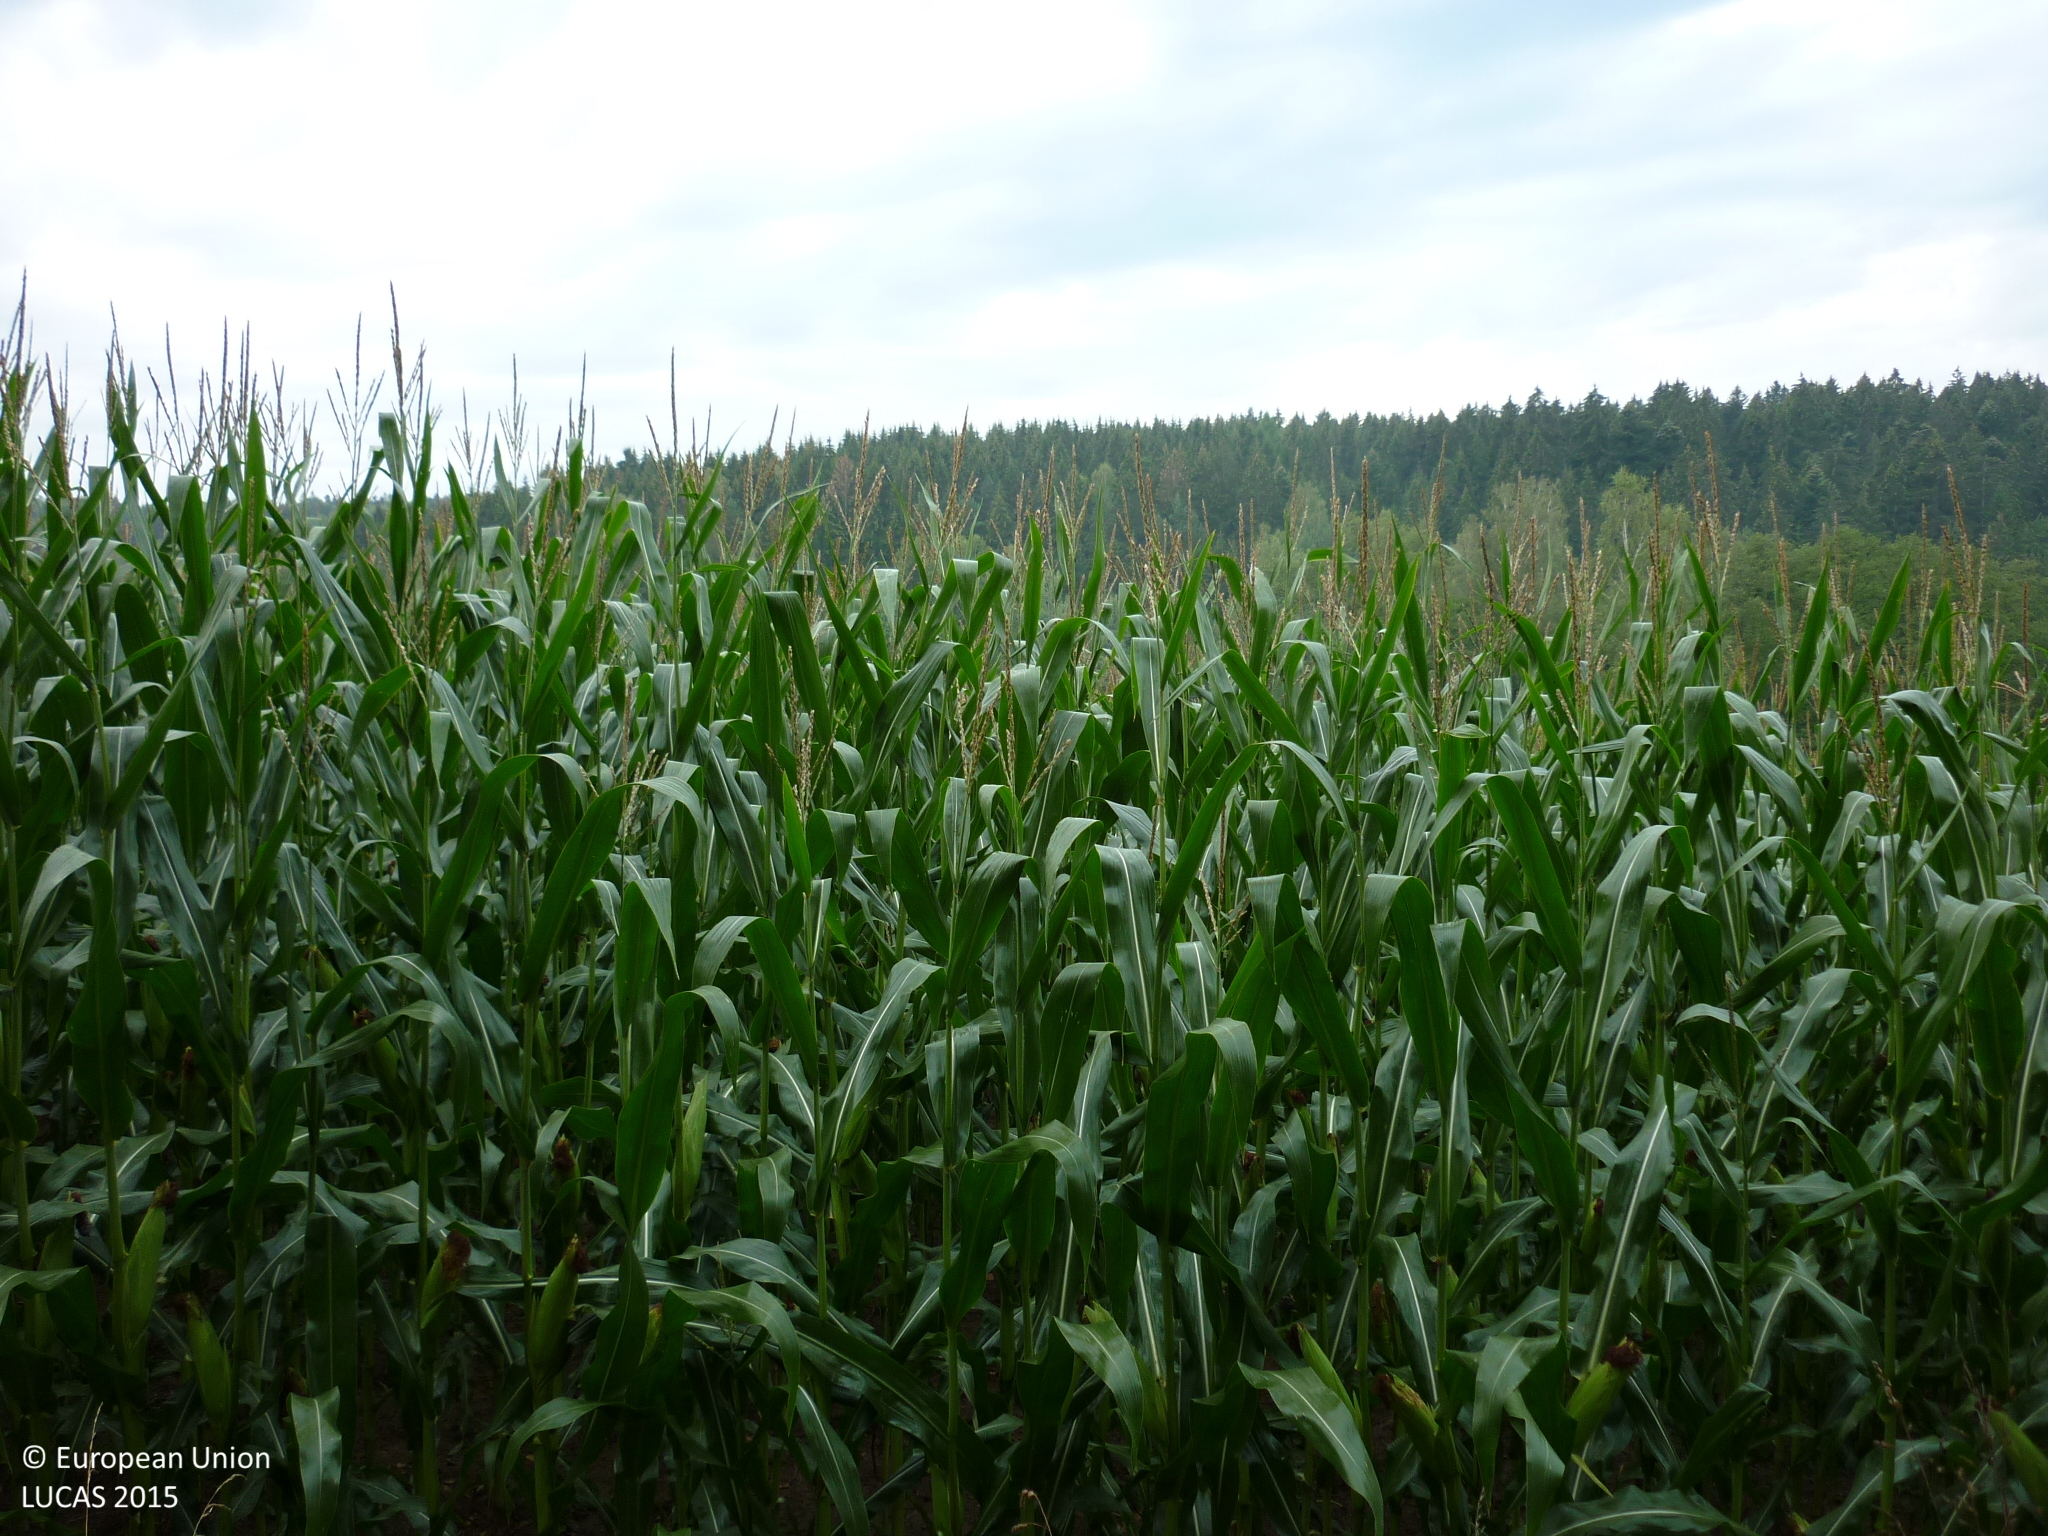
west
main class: Cropland
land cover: Maize
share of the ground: > 75 %
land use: Agriculture (excluding fallow land and kitchen gardens)
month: September
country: AT
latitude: 48.9376
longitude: 15.0396
